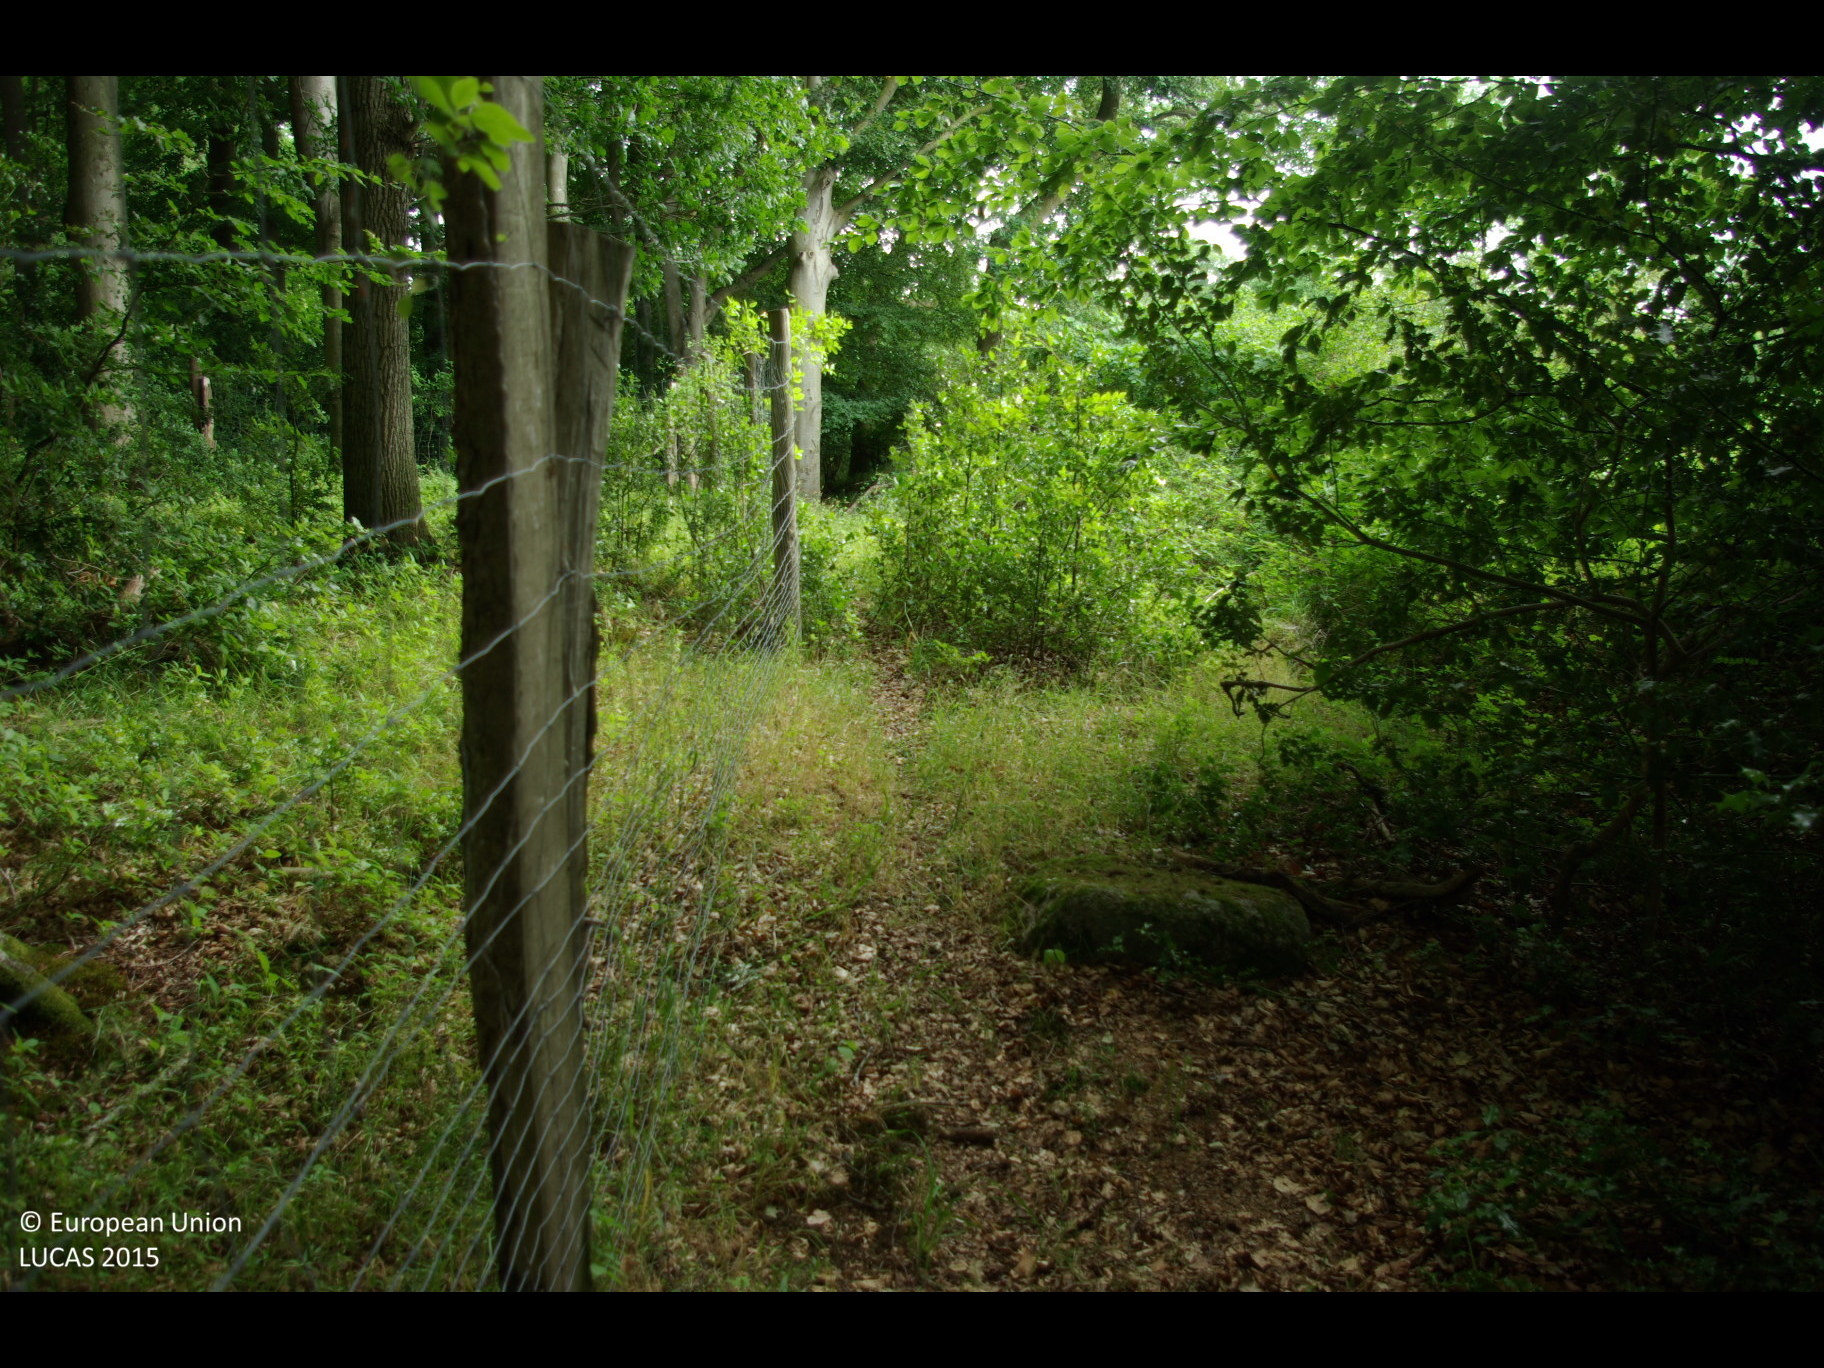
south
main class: Woodland
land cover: Broadleaved woodland
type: beech forest
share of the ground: > 75 %
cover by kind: broadleaved forest trees 90 %, herbaceous plants 10 %
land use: Semi-natural and natural areas not in use
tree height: > 5 m
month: July
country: DE
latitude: 54.6959
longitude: 9.9535
